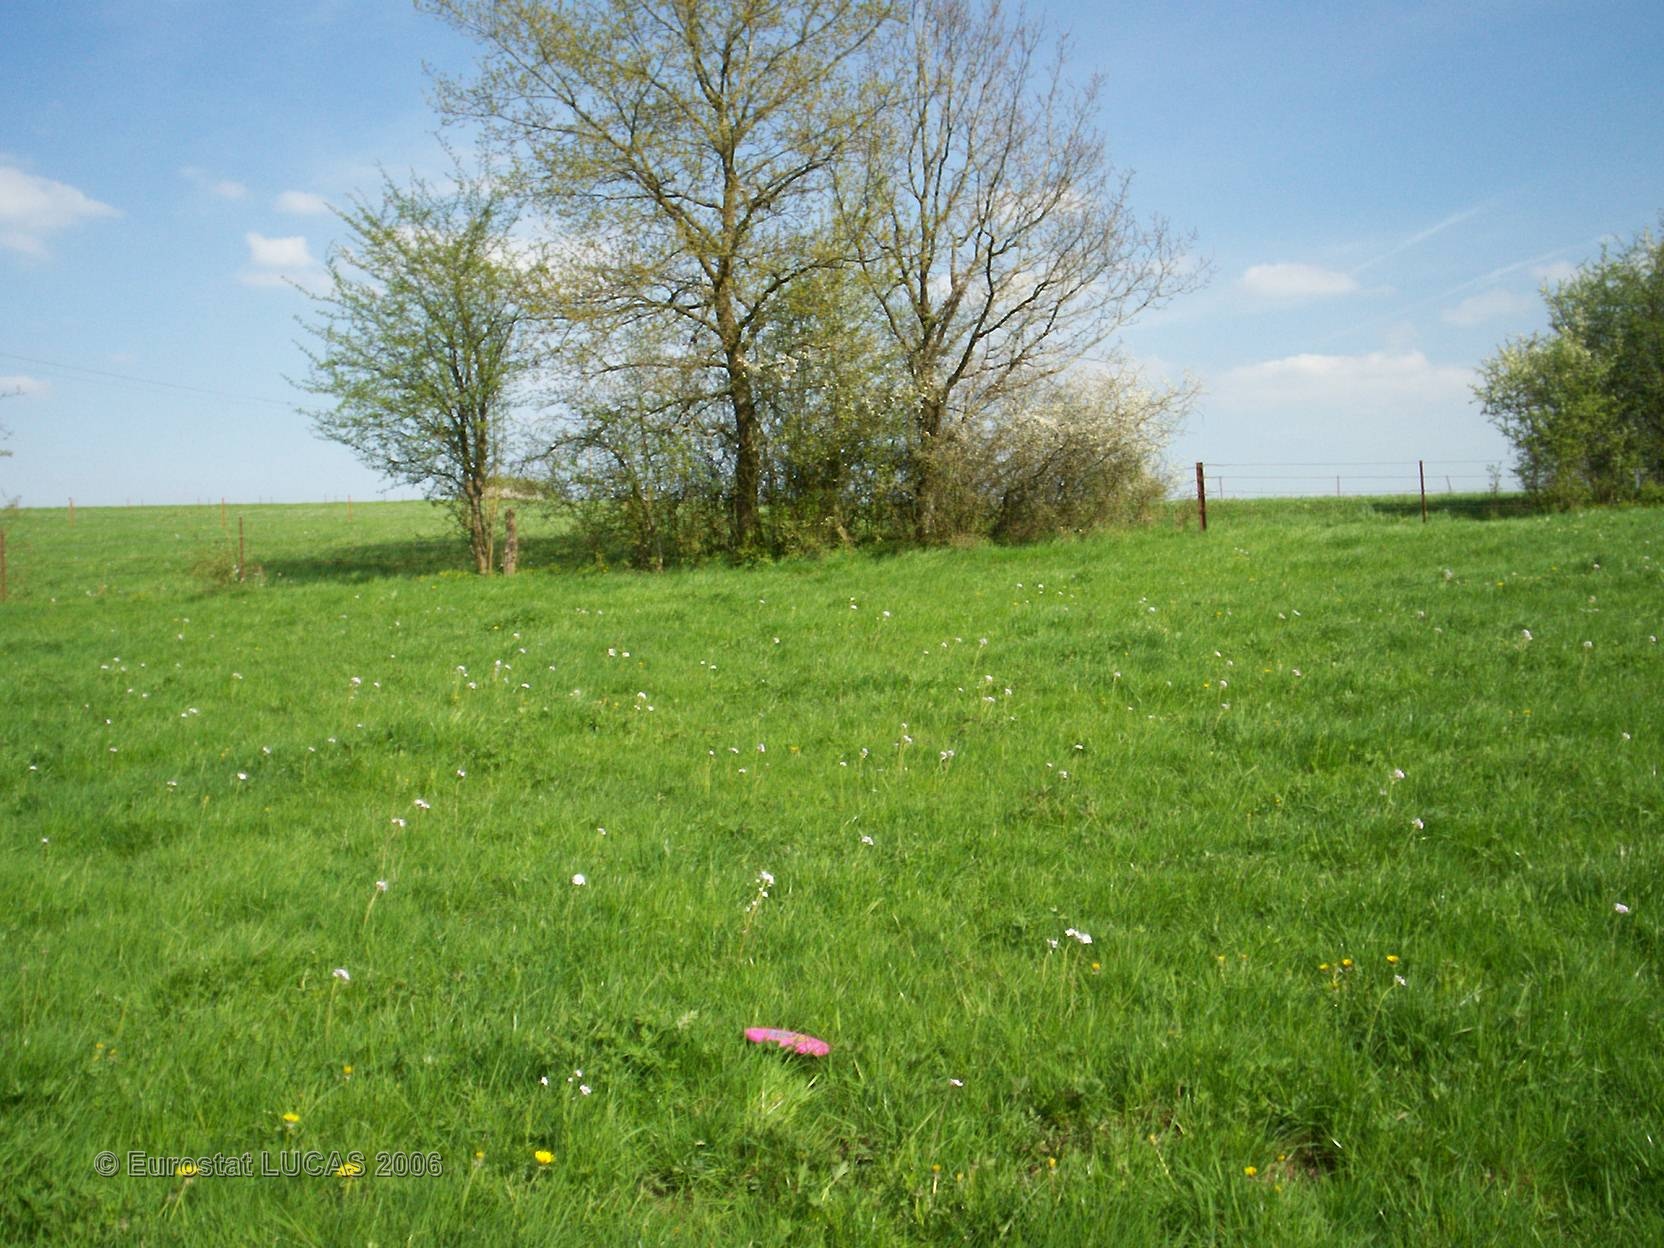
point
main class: Grassland
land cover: Grassland without tree/shrub cover
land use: Agriculture (excluding fallow land and kitchen gardens)
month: April
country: FR
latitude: 49.7349
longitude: 4.2930
